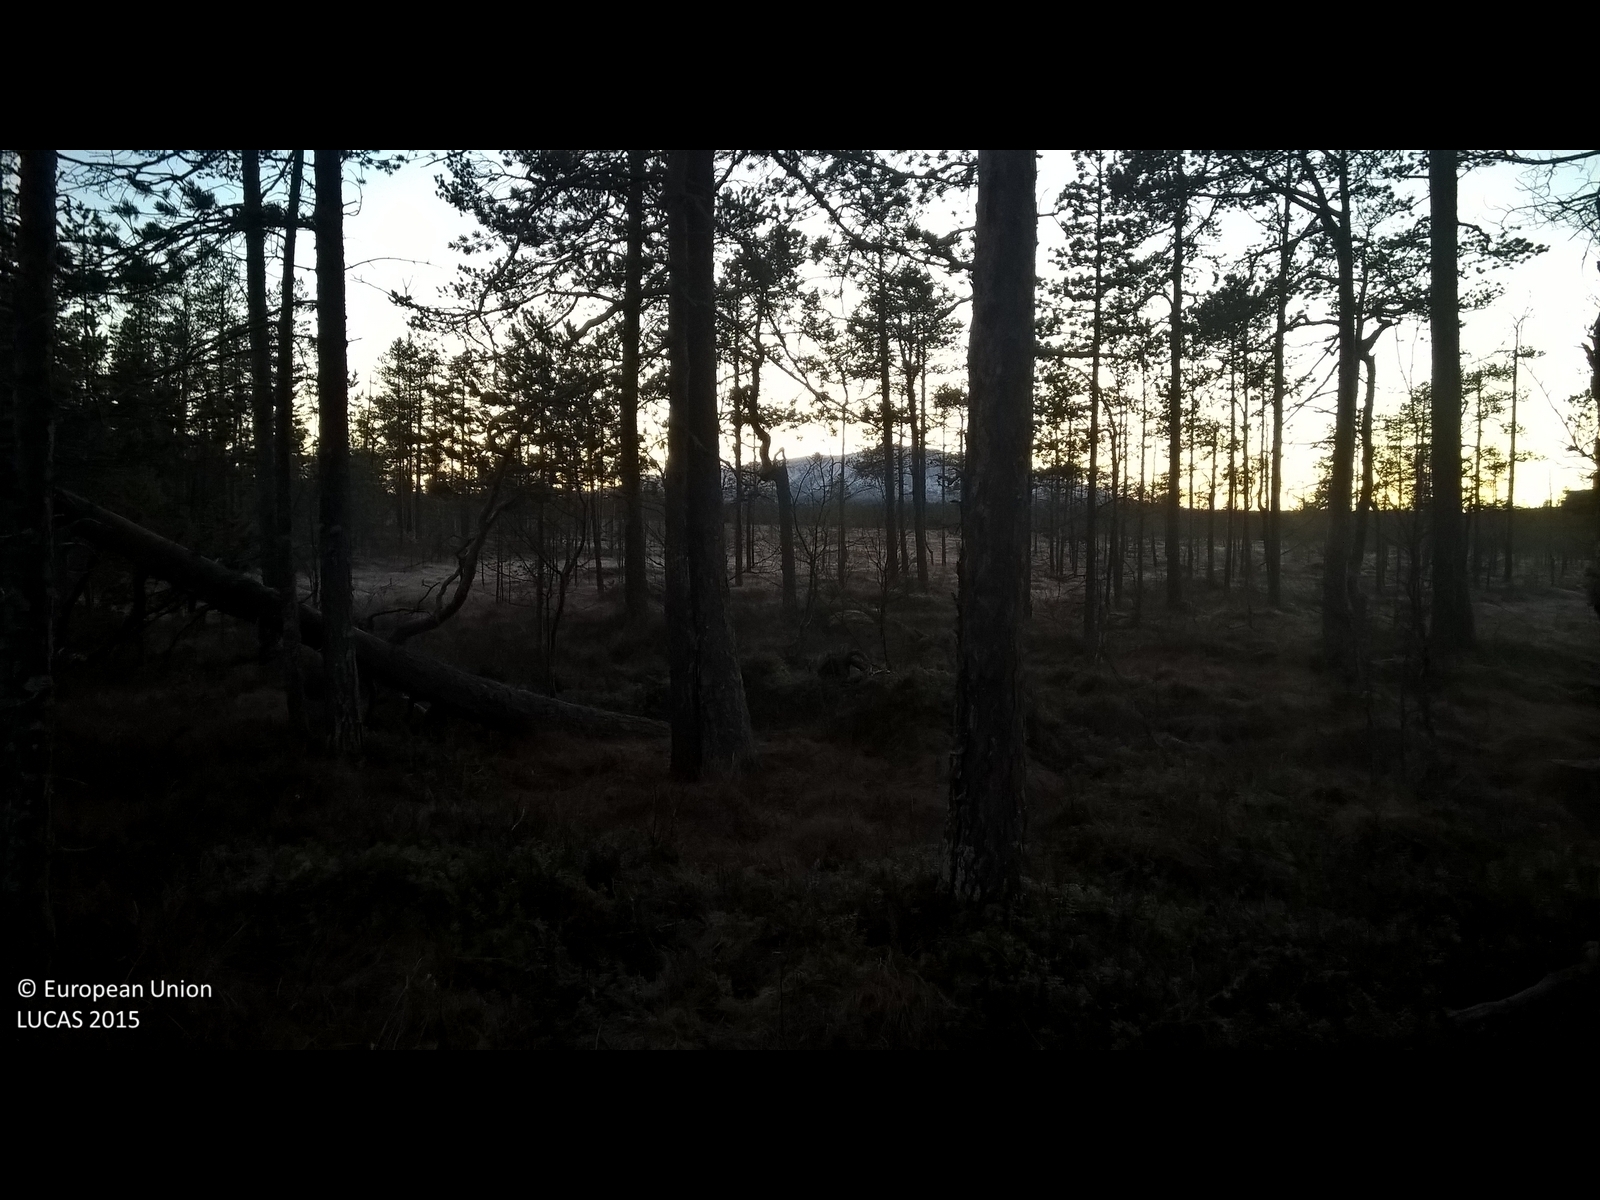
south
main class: Woodland
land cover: Pine dominated coniferous woodland
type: mire and swamp forests
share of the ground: 25 - 50 %
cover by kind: coniferous forest trees 40 %, shrubs 20 %, herbaceous plants 20 %, lichens and mosses 20 %
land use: Forestry
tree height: > 5 m
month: November
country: SE
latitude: 62.3509
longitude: 13.6738
